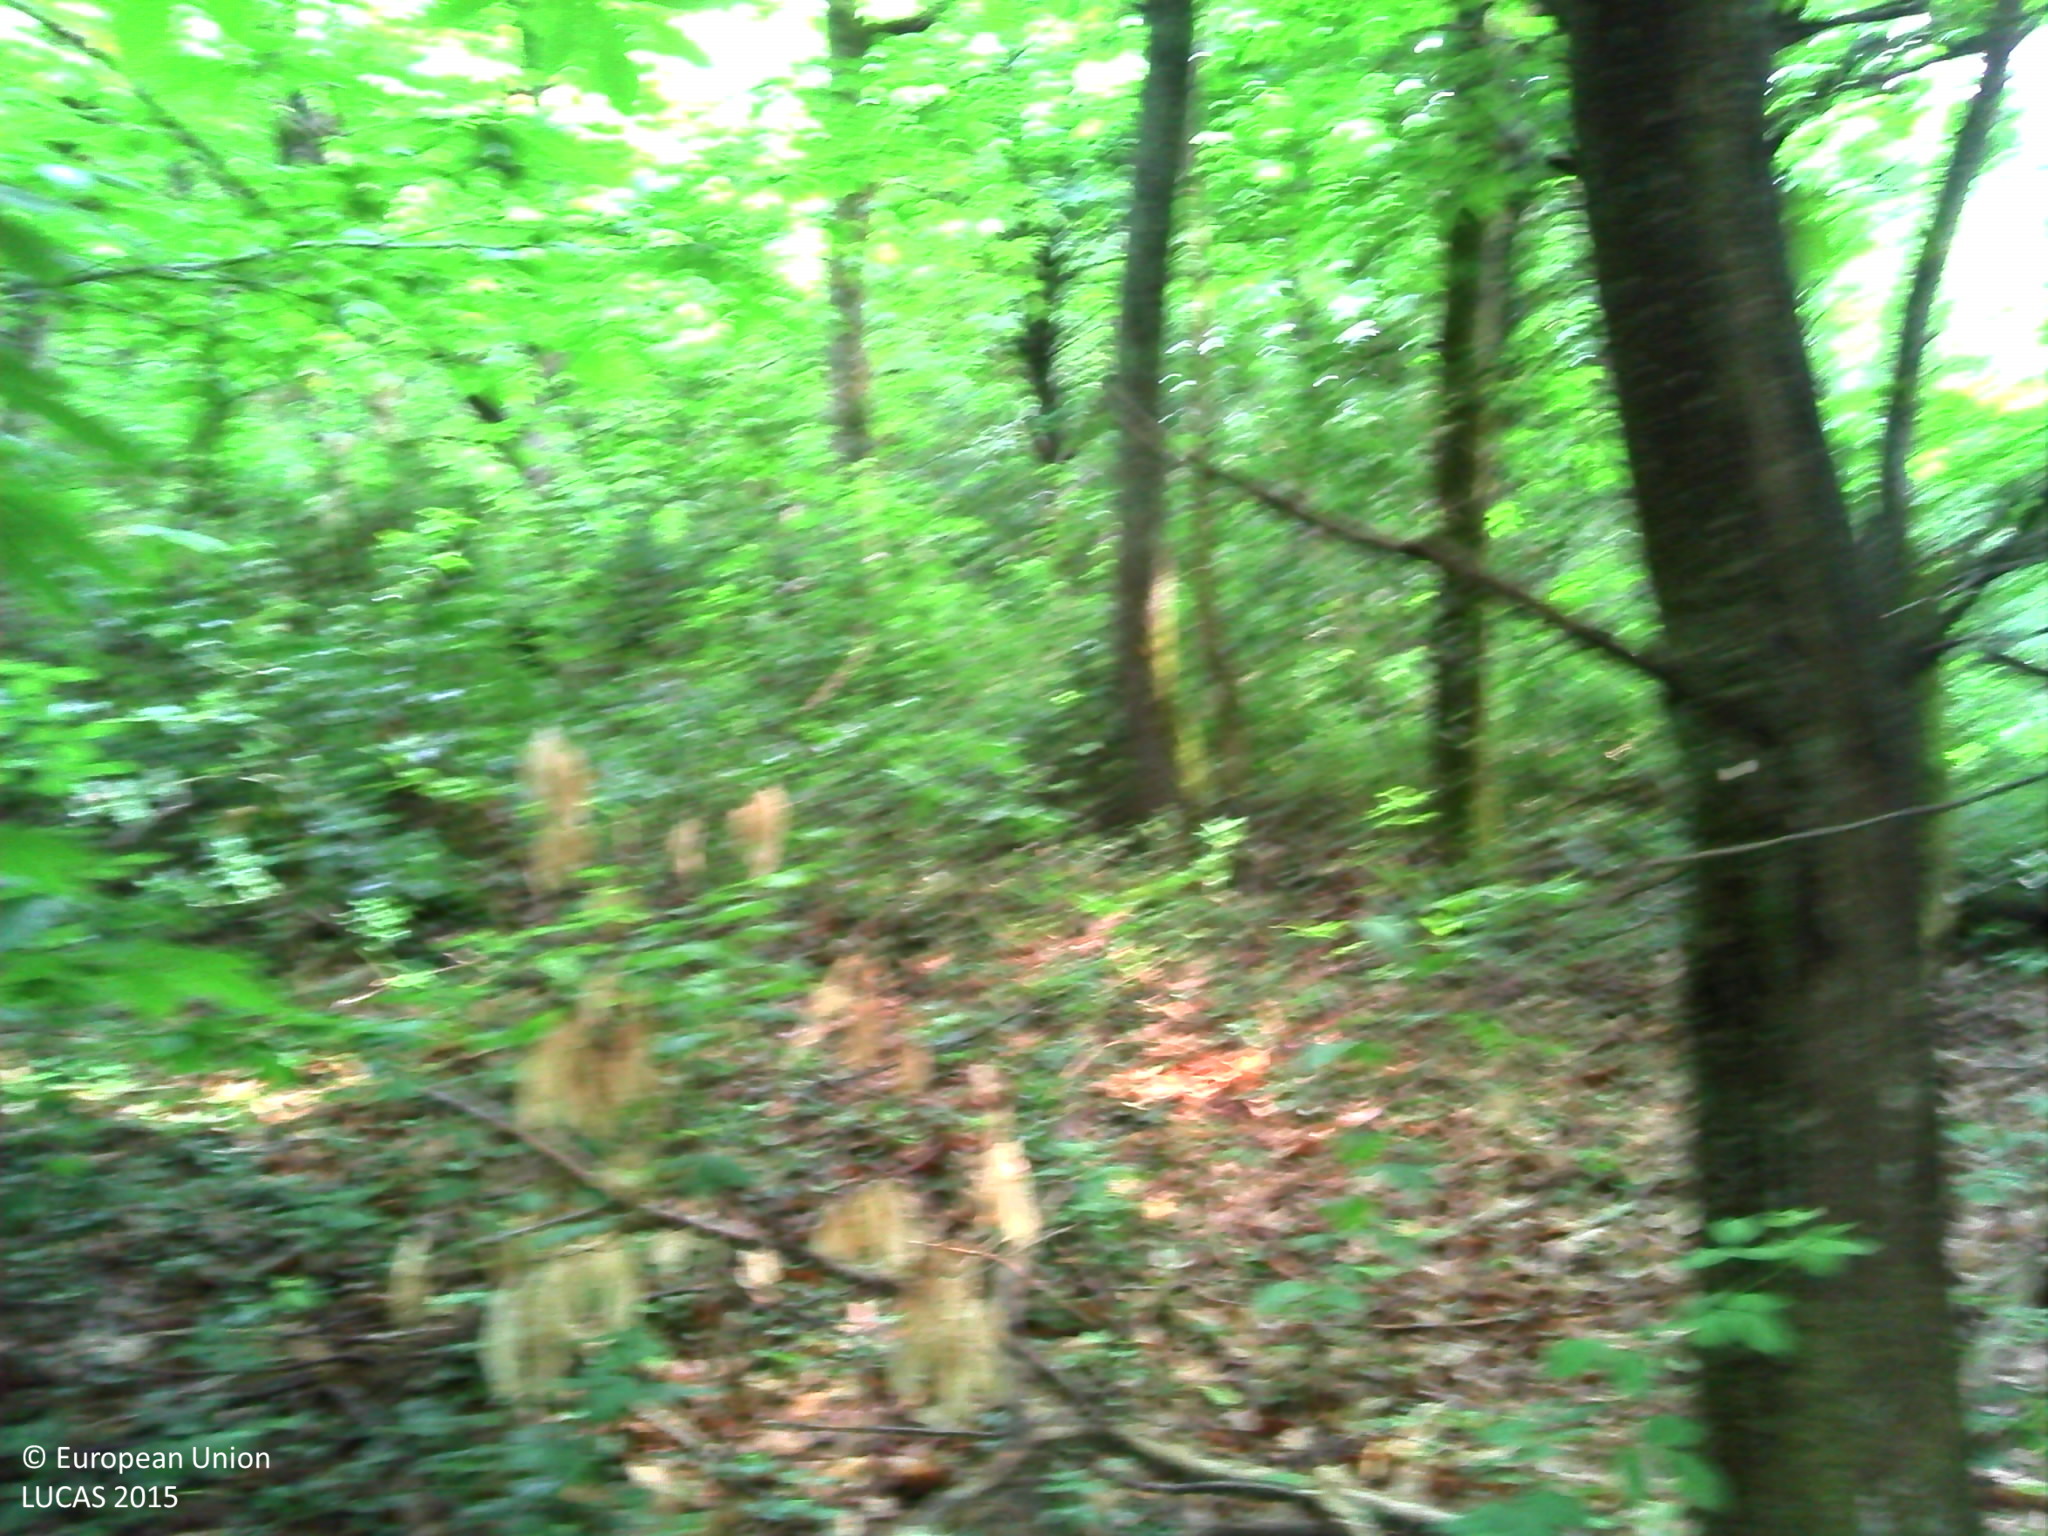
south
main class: Woodland
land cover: Broadleaved woodland
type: acidophilous oak and oak-birch forest
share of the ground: > 75 %
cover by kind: broadleaved forest trees 90 %, shrubs 5 %, herbaceous plants 5 %
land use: Forestry
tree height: > 5 m
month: June
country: FR
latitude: 43.6457
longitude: -0.2109
